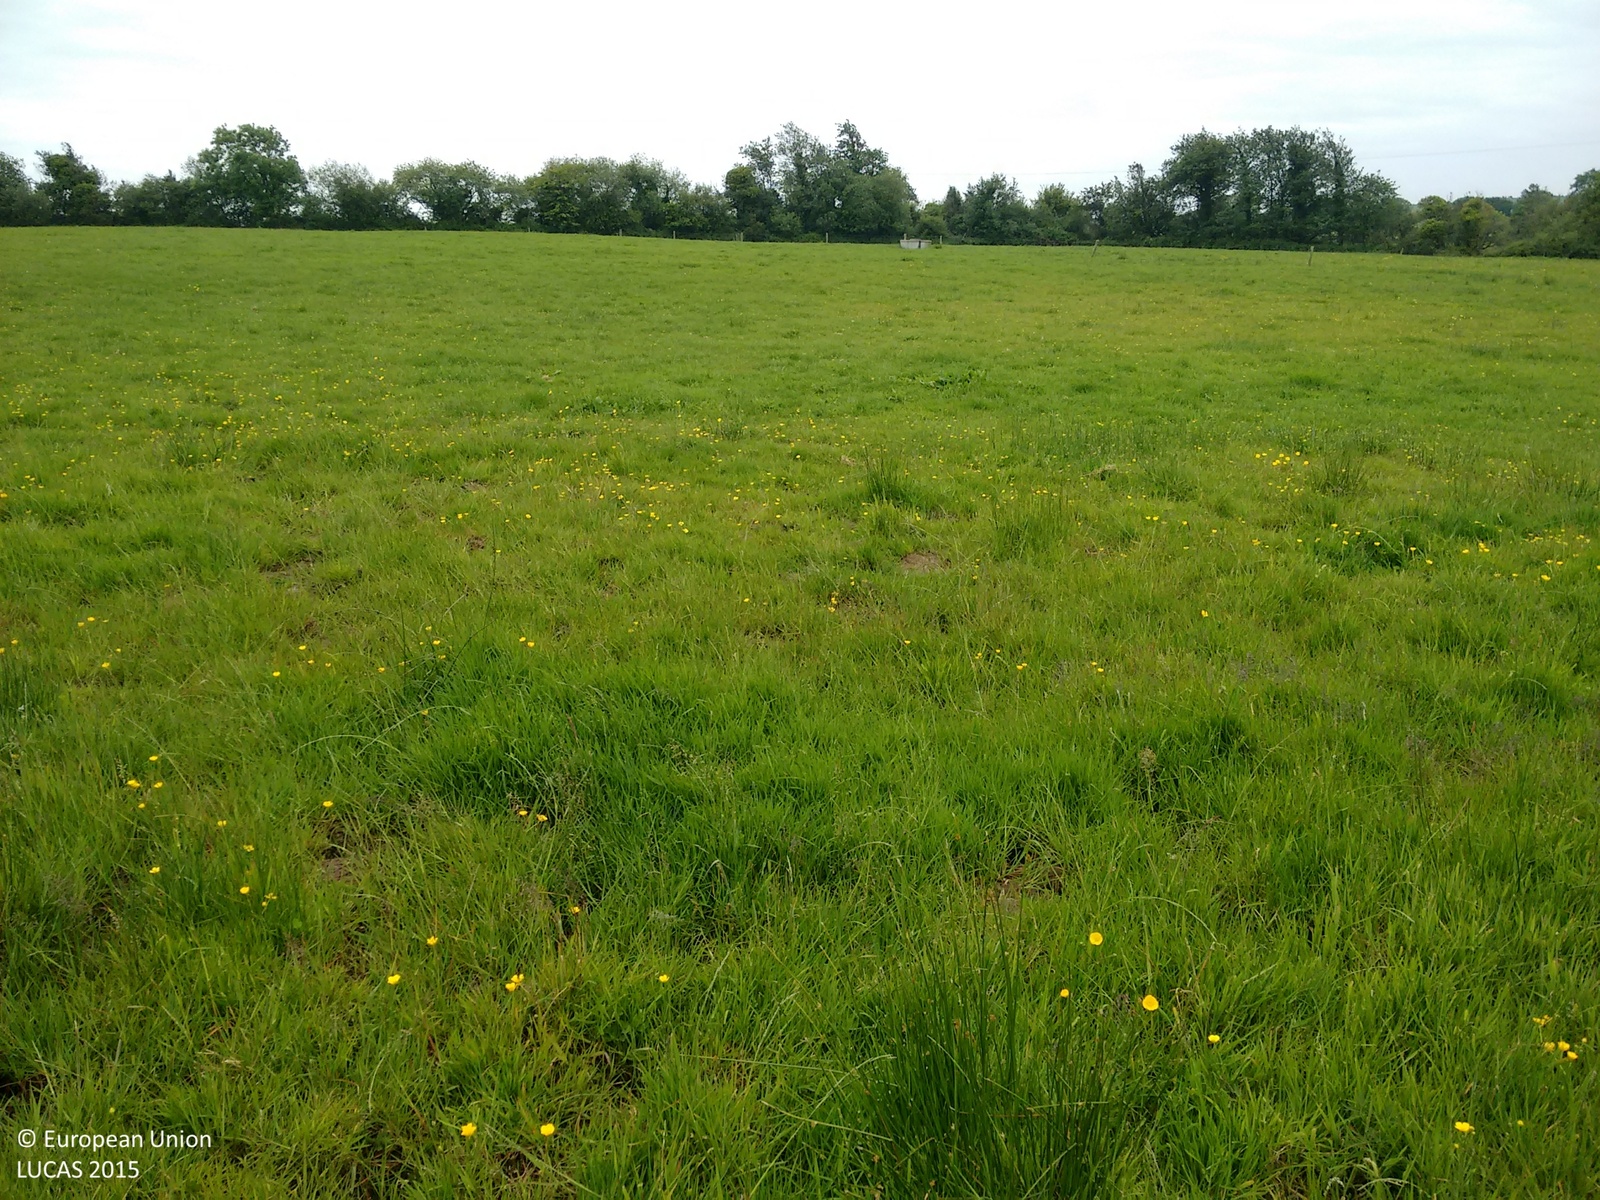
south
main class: Grassland
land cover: Grassland without tree/shrub cover
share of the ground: > 75 %
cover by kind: herbaceous plants 100 %
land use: Agriculture (excluding fallow land and kitchen gardens)
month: June
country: IE
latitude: 51.9790
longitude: -8.0112
